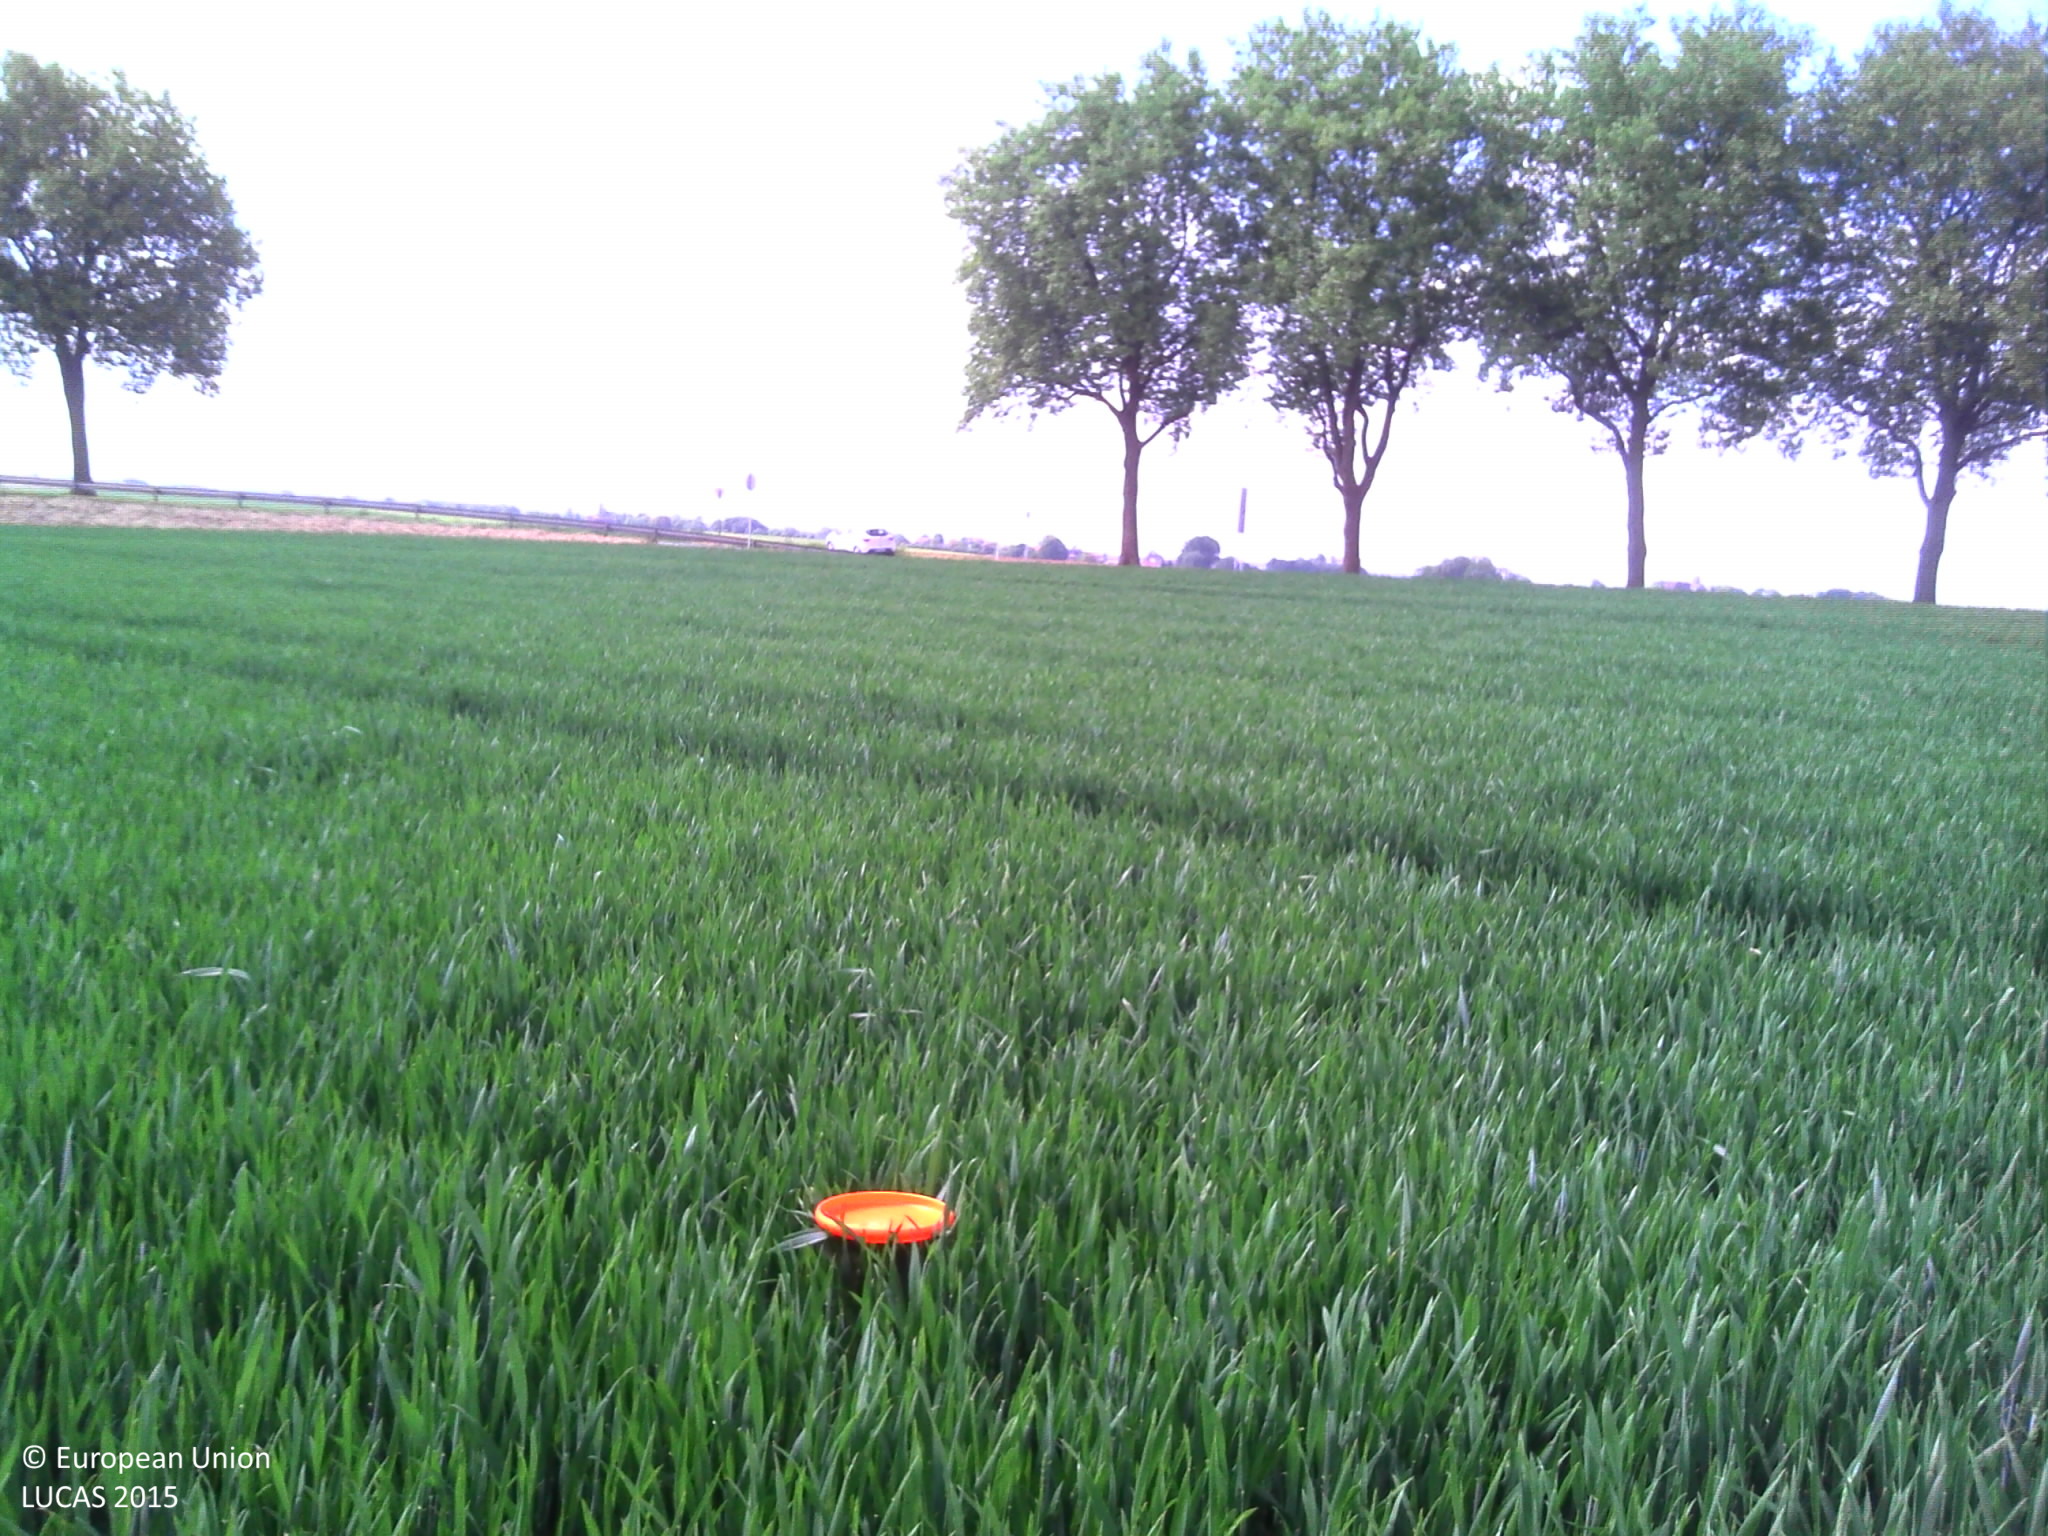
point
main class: Cropland
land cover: Common wheat
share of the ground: > 75 %
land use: Agriculture (excluding fallow land and kitchen gardens)
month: May
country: BE
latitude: 50.5399
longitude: 4.5353
